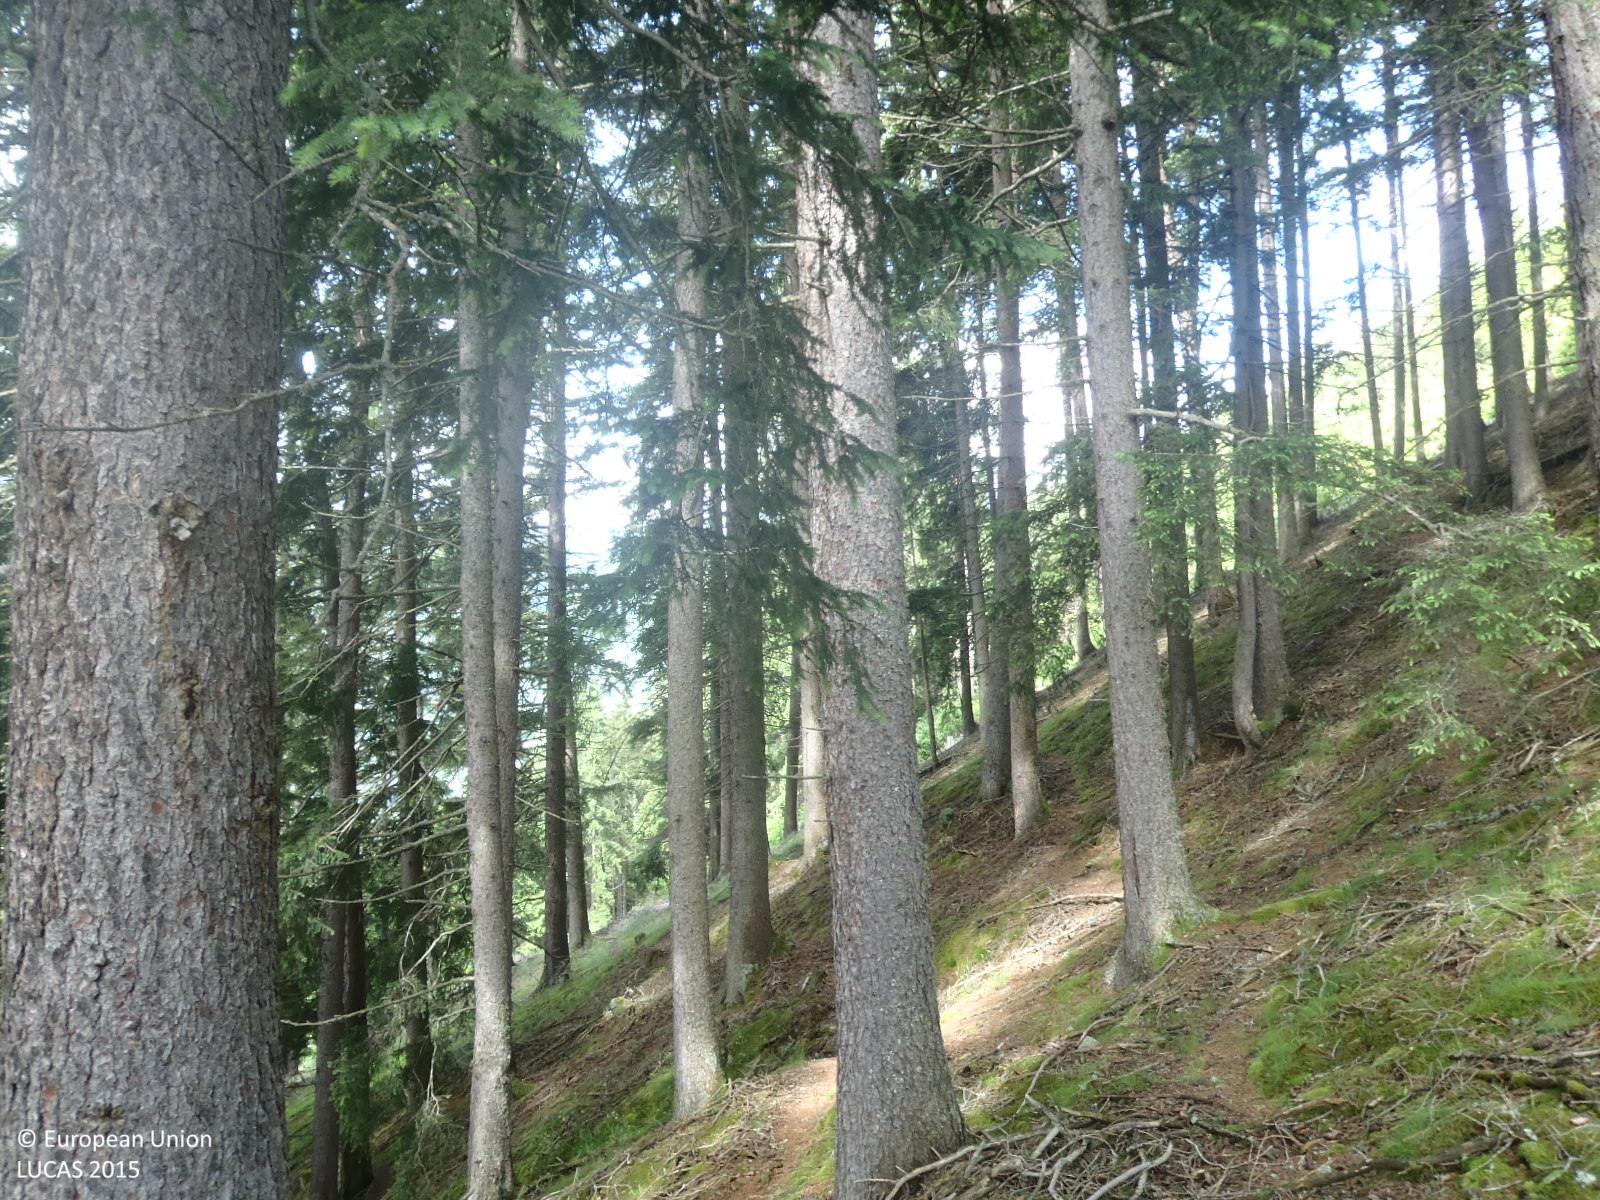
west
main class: Woodland
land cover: Spruce dominated coniferous woodland
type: alpine coniferous forest
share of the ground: > 75 %
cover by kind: coniferous forest trees 90 %, herbaceous plants 5 %, lichens and mosses 5 %
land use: Forestry
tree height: > 5 m
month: June
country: AT
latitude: 47.1697
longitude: 11.4630
